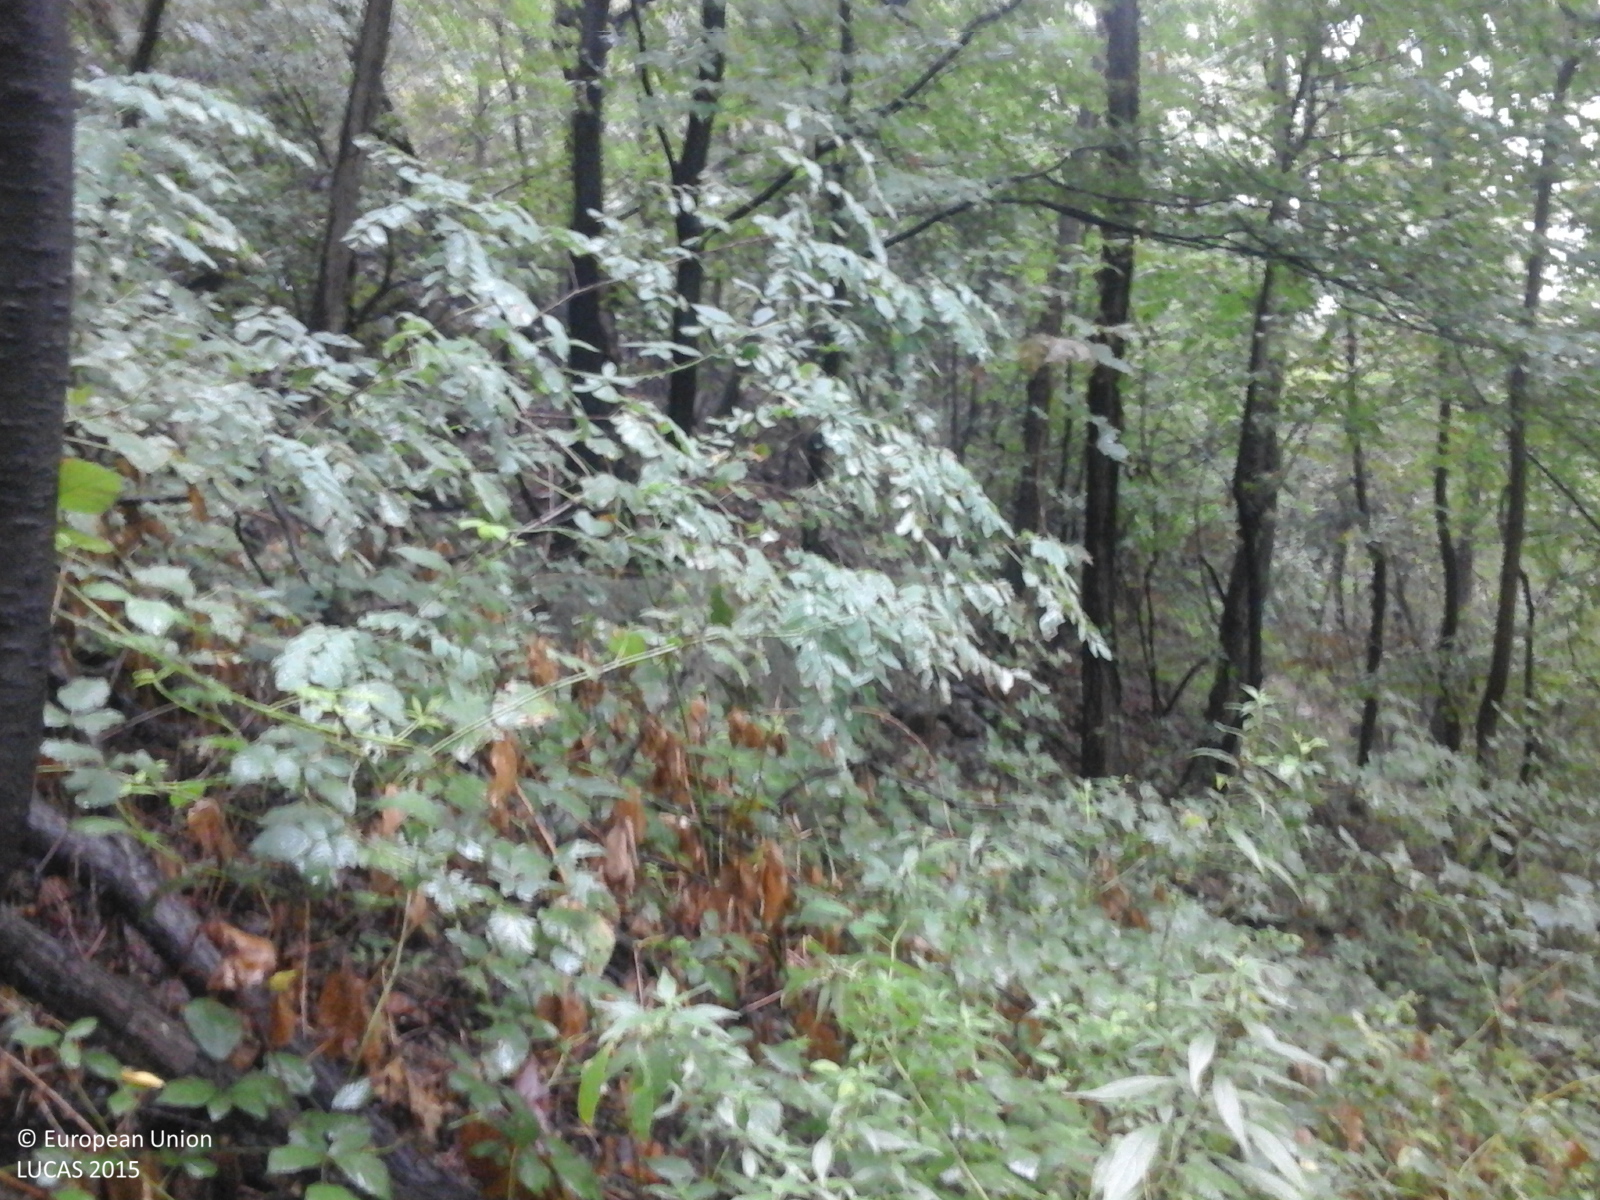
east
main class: Woodland
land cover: Broadleaved woodland
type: mesophytic deciduous forest
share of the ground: > 75 %
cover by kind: broadleaved forest trees 100 %
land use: Forestry
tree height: > 5 m
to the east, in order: Broadleaved woodland; Grassland without tree/shrub cover; Broadleaved woodland
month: September
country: RO
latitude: 45.1953
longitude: 23.3843
